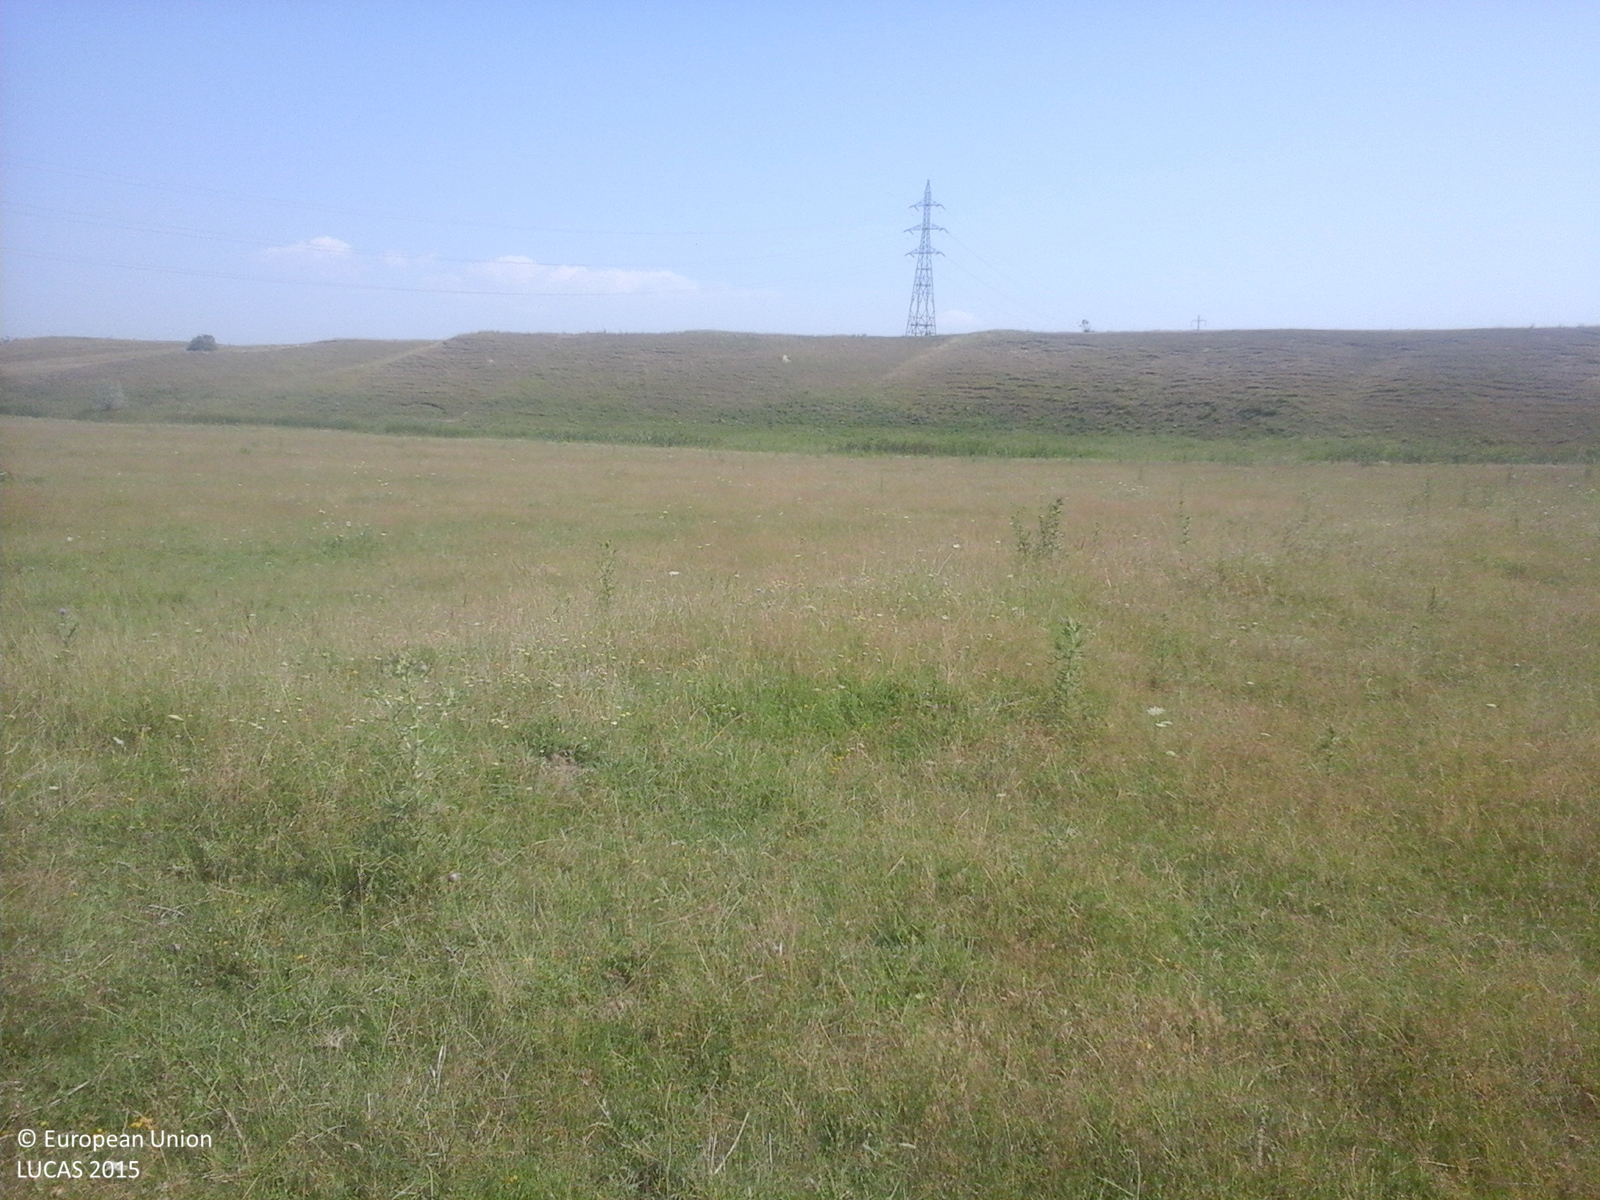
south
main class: Grassland
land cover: Grassland without tree/shrub cover
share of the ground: > 75 %
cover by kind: herbaceous plants 100 %
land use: Agriculture (excluding fallow land and kitchen gardens)
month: July
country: RO
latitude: 44.8938
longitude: 27.7166
